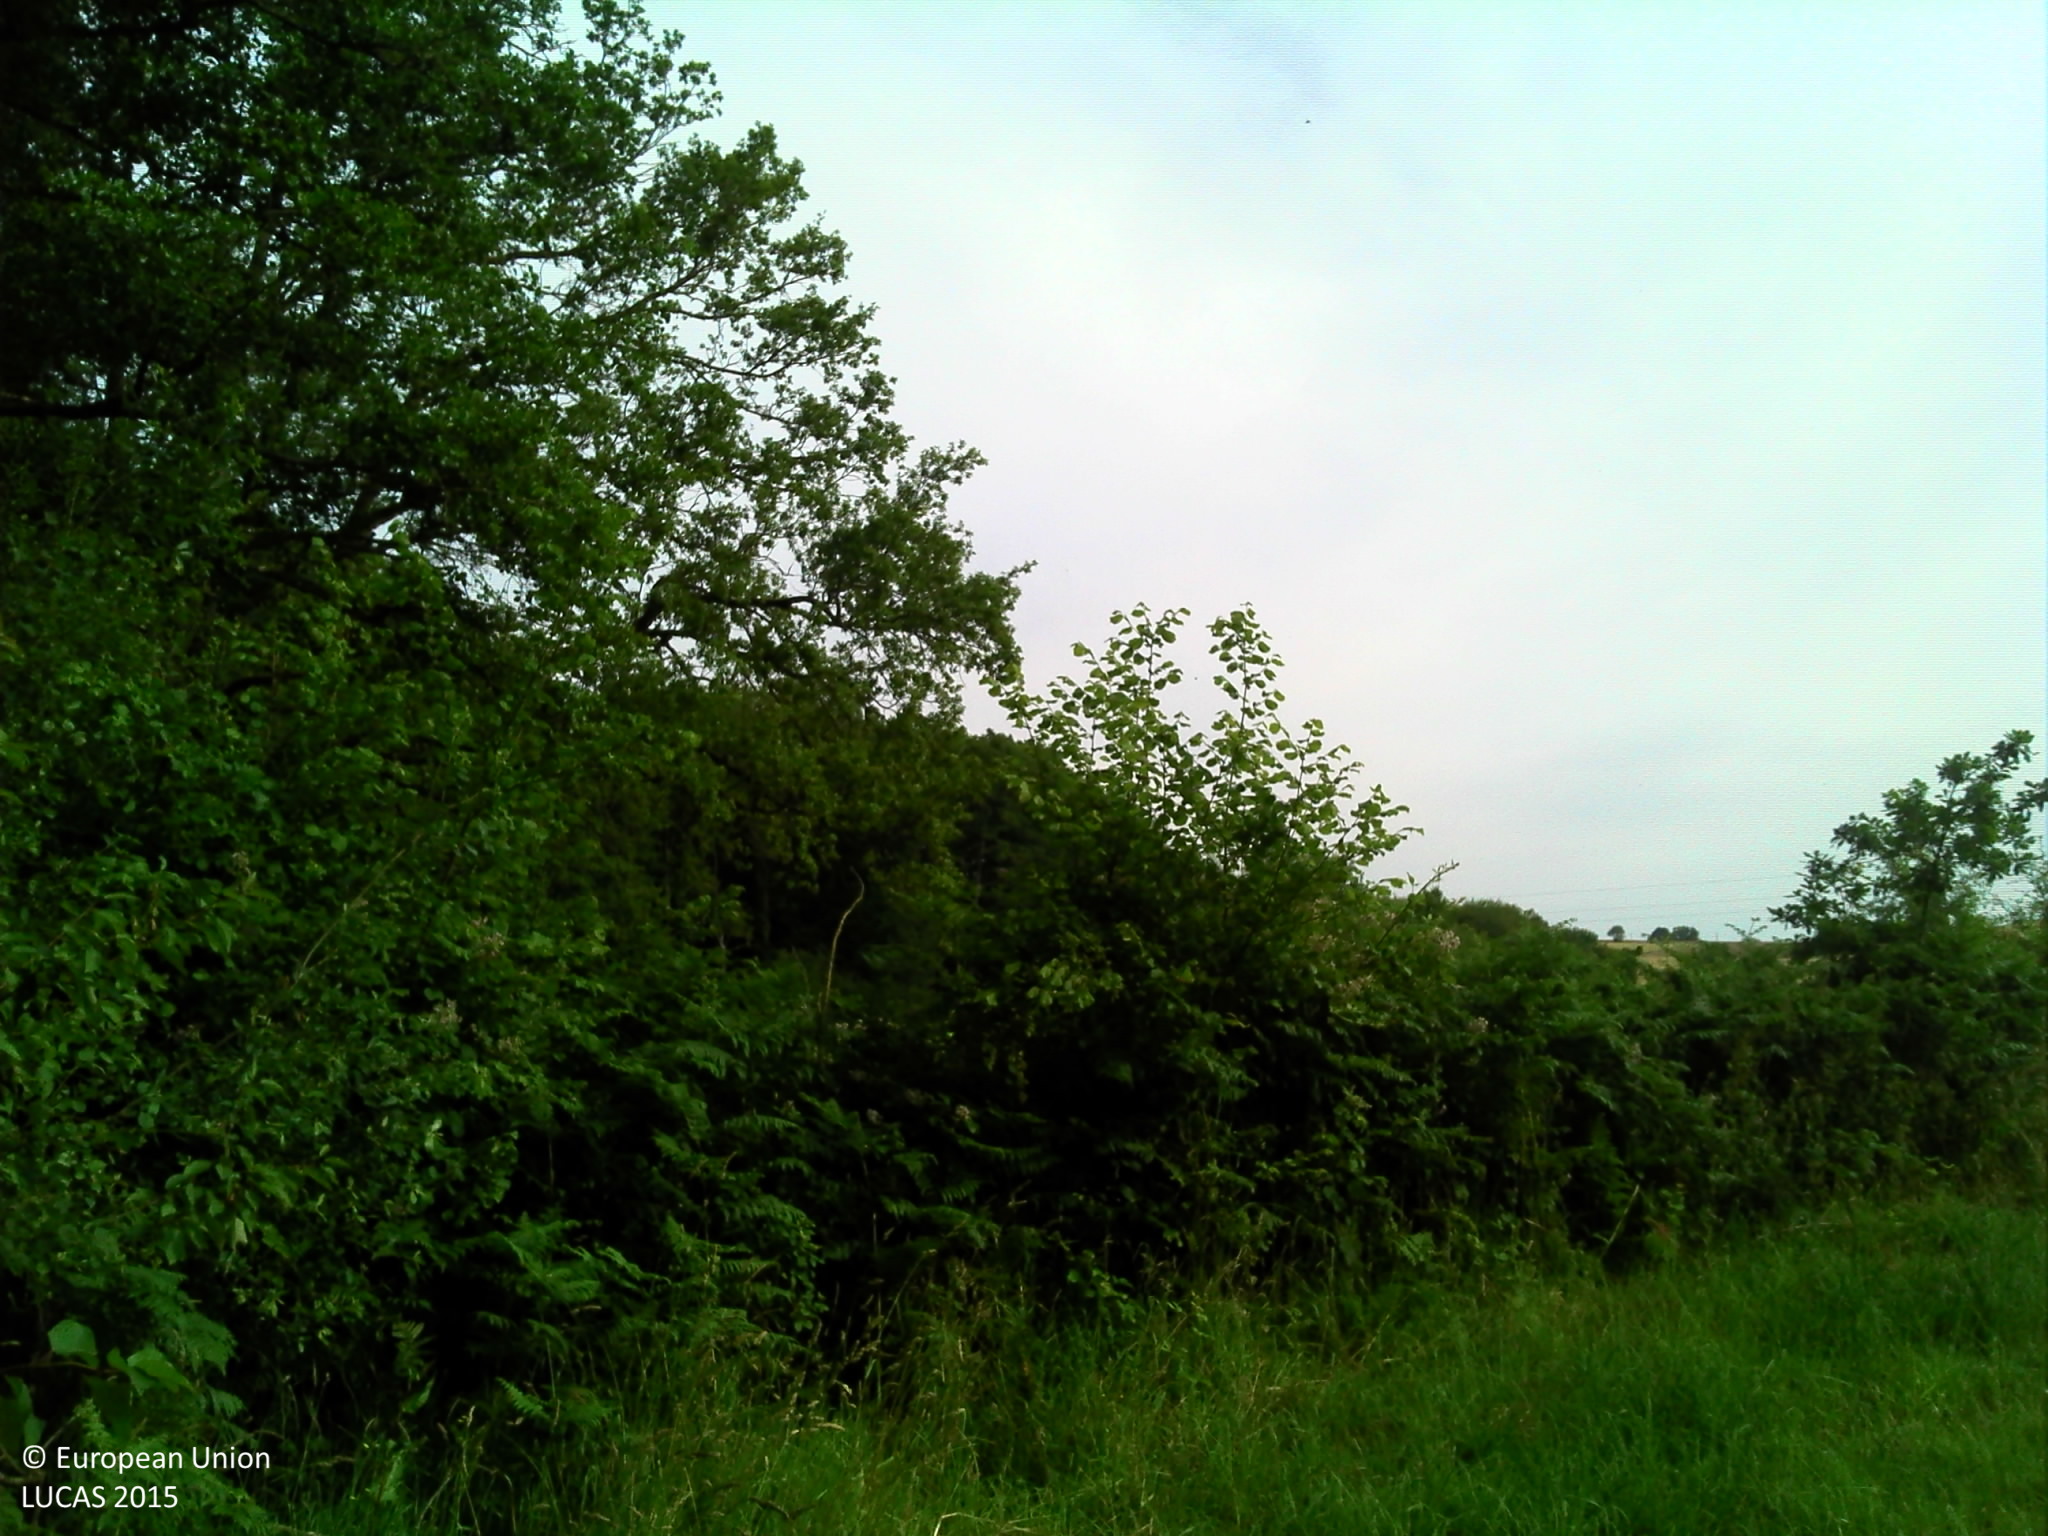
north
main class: Woodland
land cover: Broadleaved woodland
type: acidophilous oak and oak-birch forest
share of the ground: > 75 %
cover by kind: broadleaved forest trees 70 %, shrubs 15 %, herbaceous plants 15 %
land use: Forestry
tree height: > 5 m
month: June
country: FR
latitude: 48.3493
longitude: 0.2170
